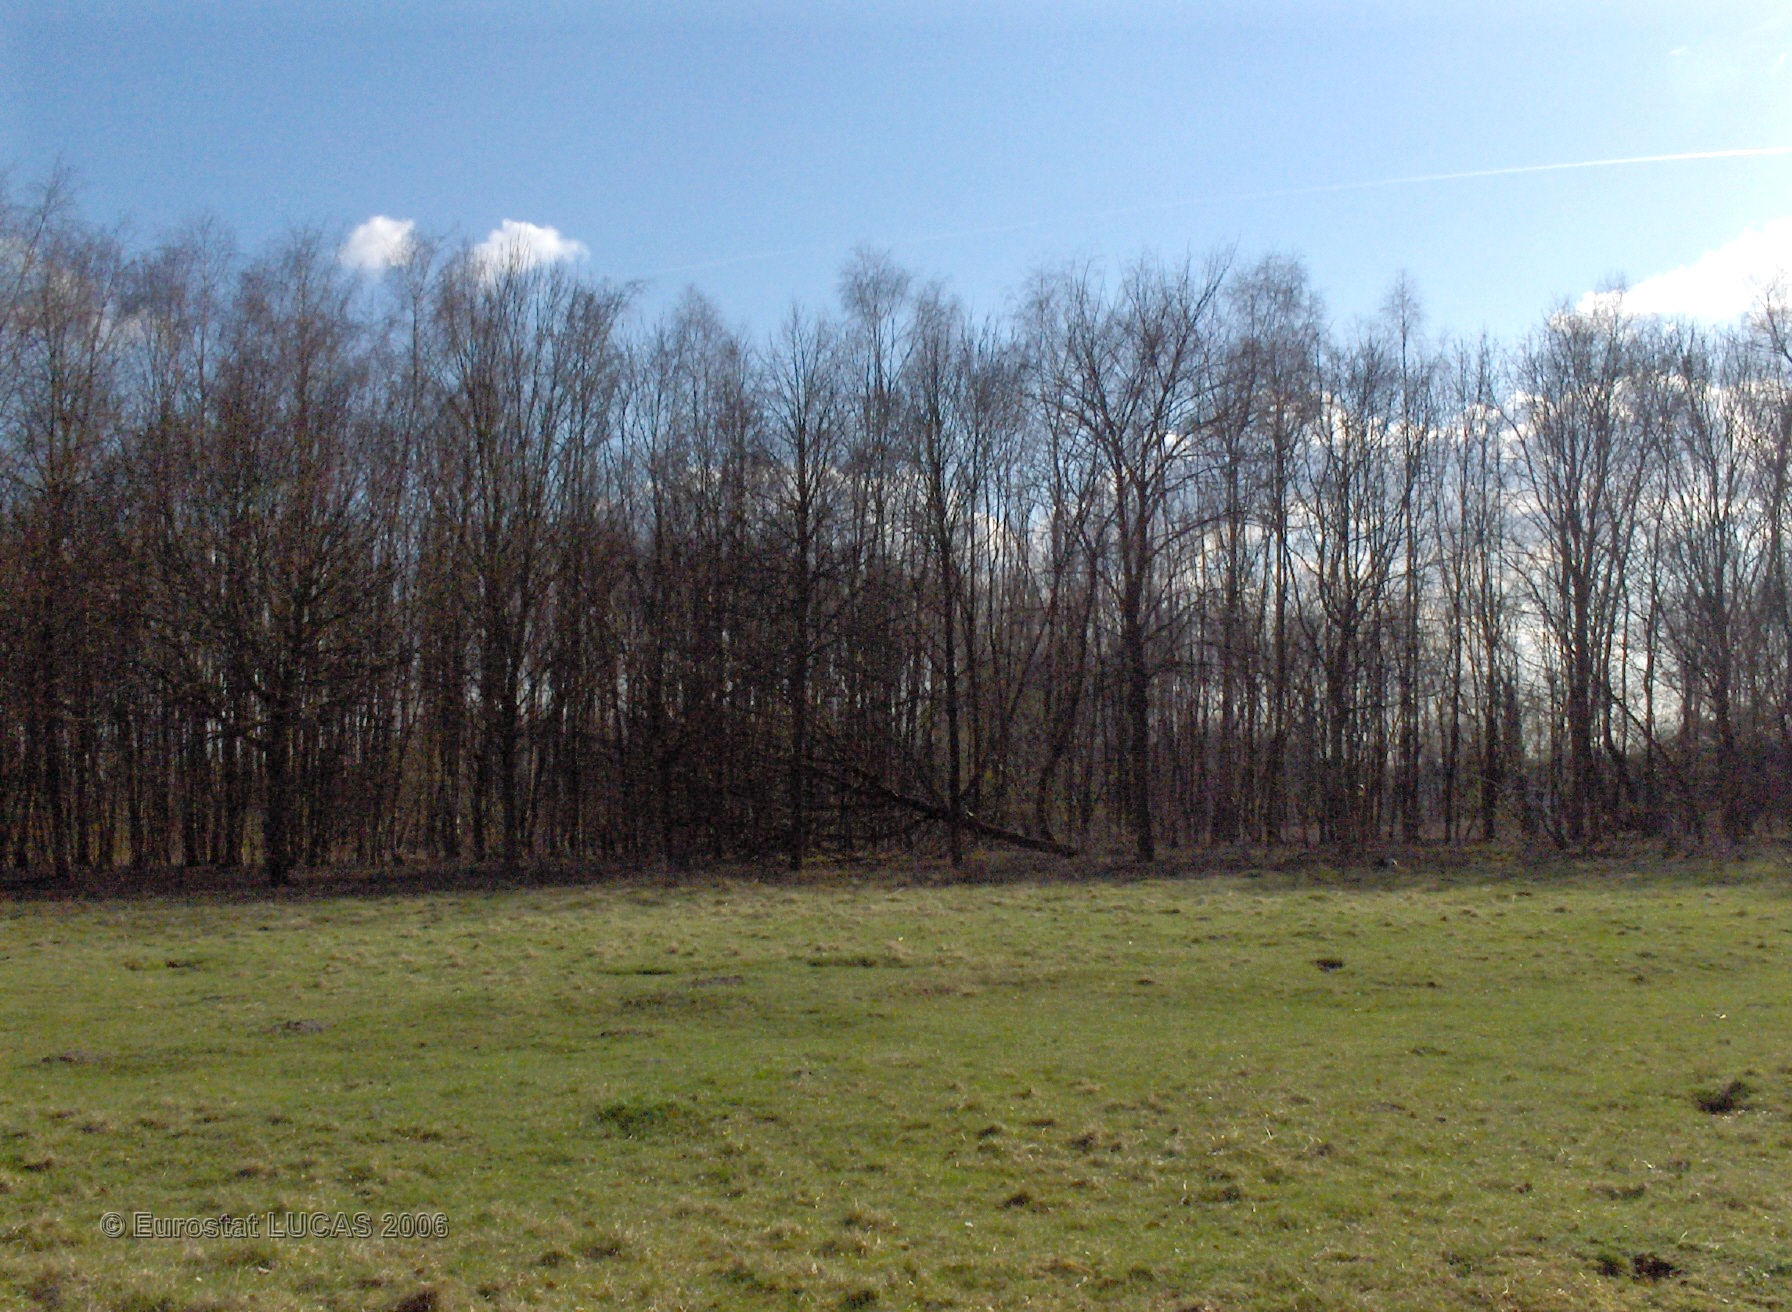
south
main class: Grassland
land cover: Grassland with sparse tree/shrub cover
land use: Agriculture (excluding fallow land and kitchen gardens)
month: April
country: BE
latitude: 51.1657
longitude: 4.4325
